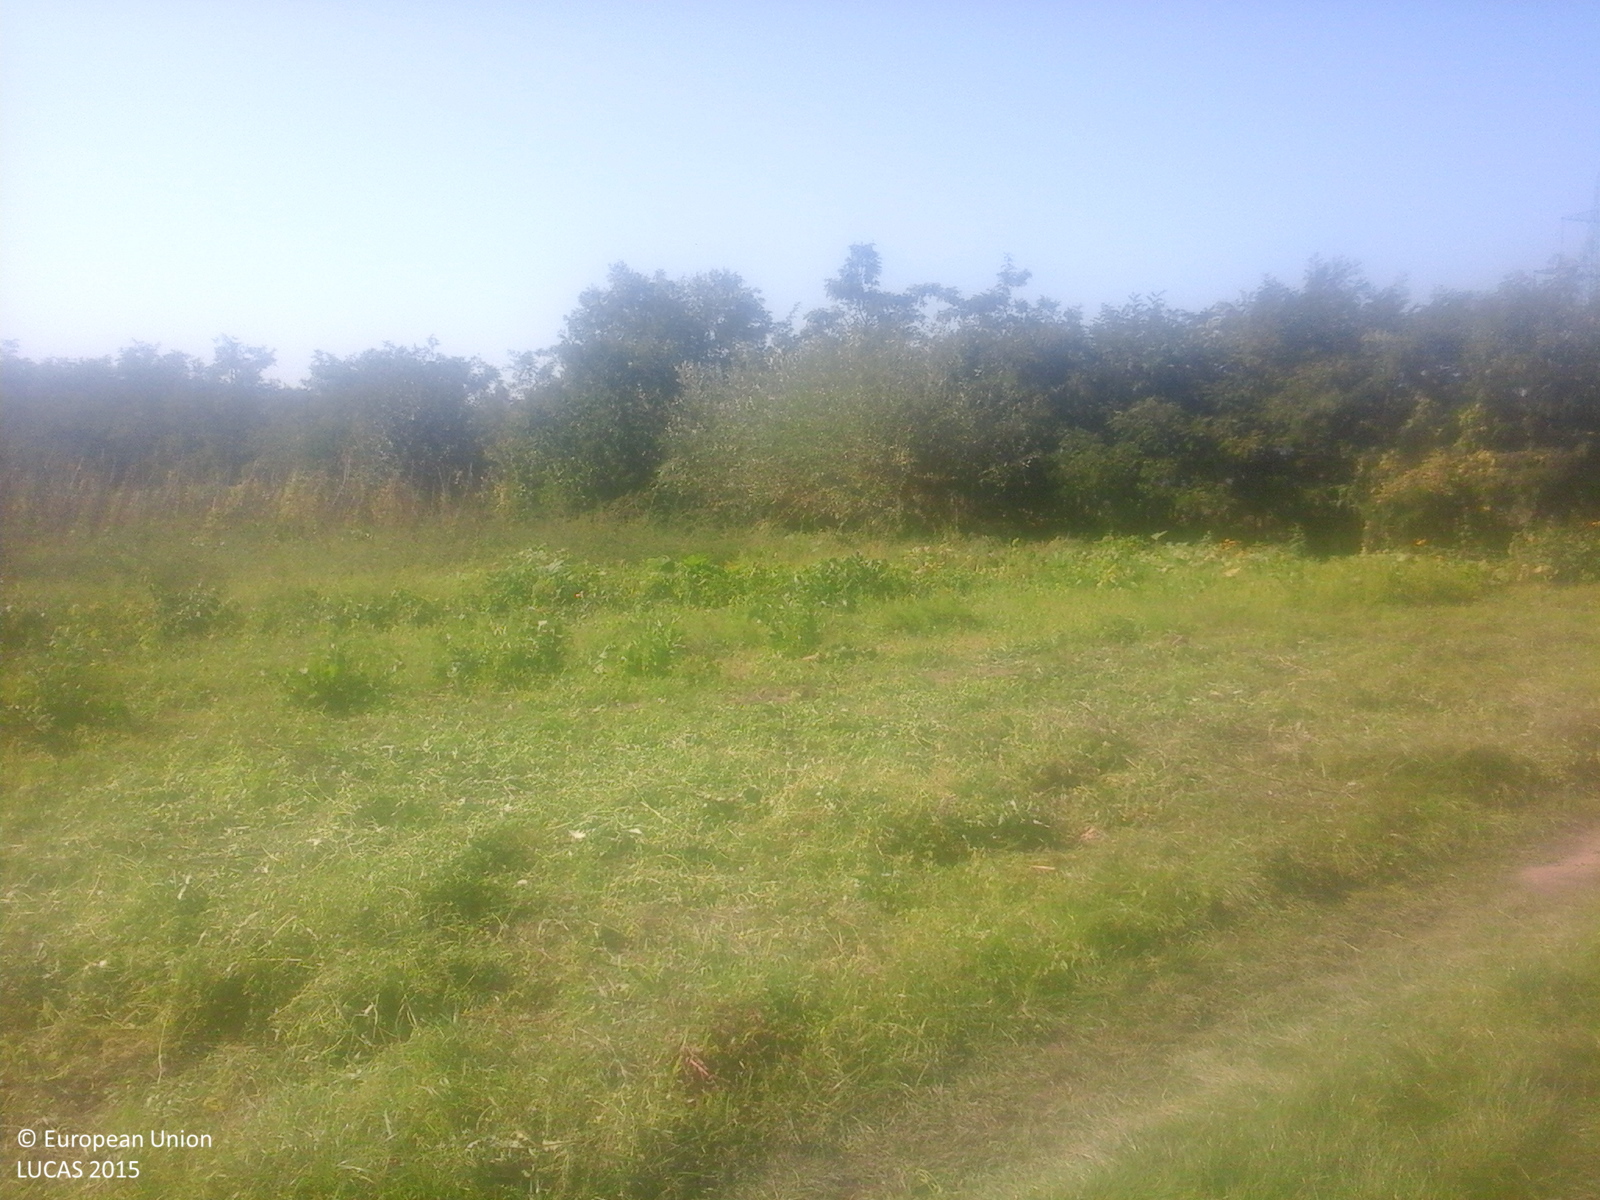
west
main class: Cropland
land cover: Lucerne
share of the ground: > 75 %
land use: Agriculture (excluding fallow land and kitchen gardens)
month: October
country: RO
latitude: 46.5034
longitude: 23.7151
